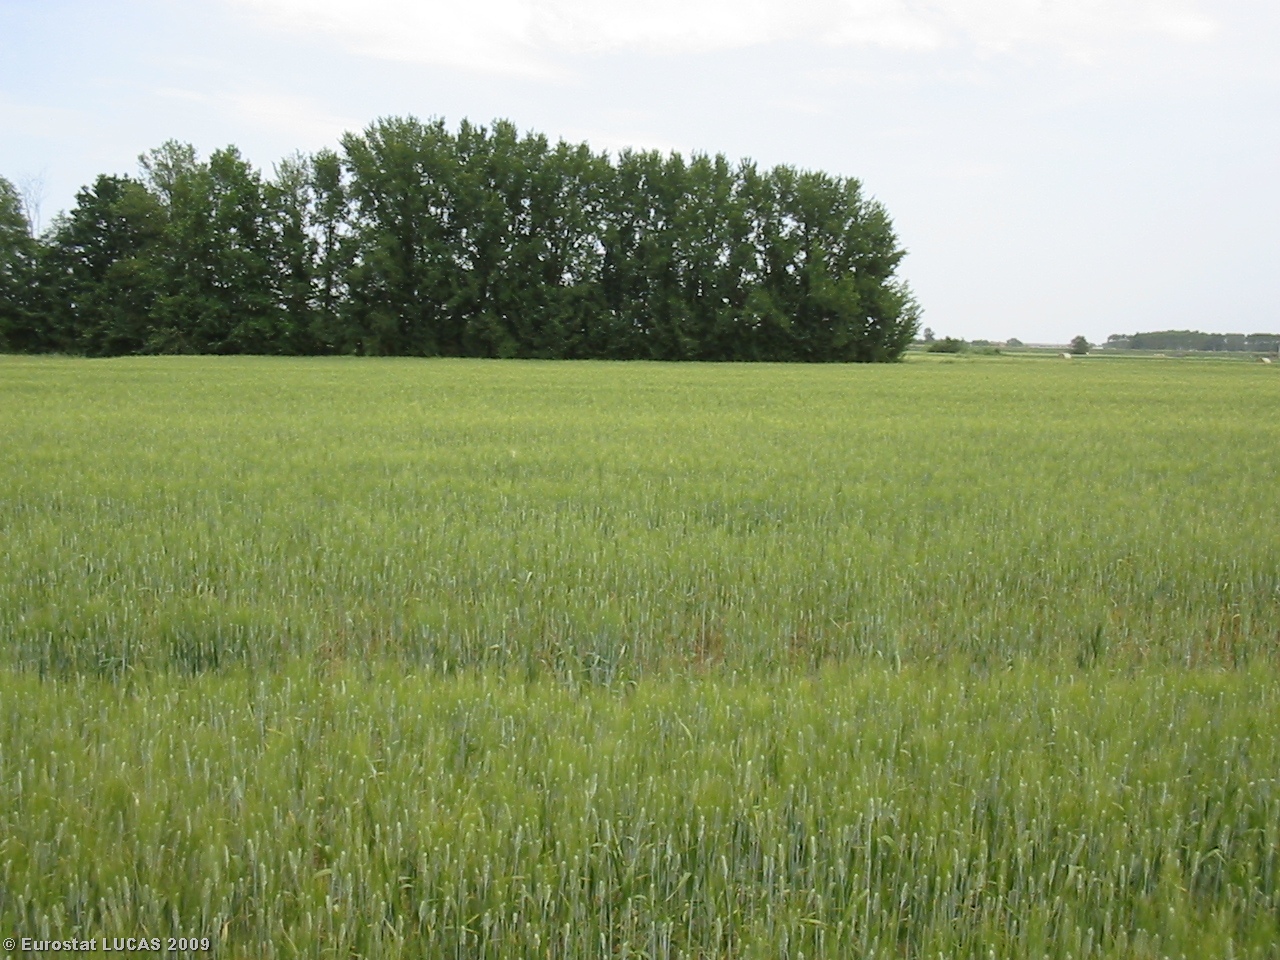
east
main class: Cropland
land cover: Common wheat
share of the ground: > 75 %
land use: Agriculture (excluding fallow land and kitchen gardens)
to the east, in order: Common wheat; Ditches and canals; Common wheat; Ditches and canals; Tracks; Common wheat; Abandoned hedges; Ditches and canals; Common wheat; Ditches and canals; Common wheat; Ditches and canals; Common wheat
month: May
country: IT
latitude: 44.9086
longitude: 10.4424
